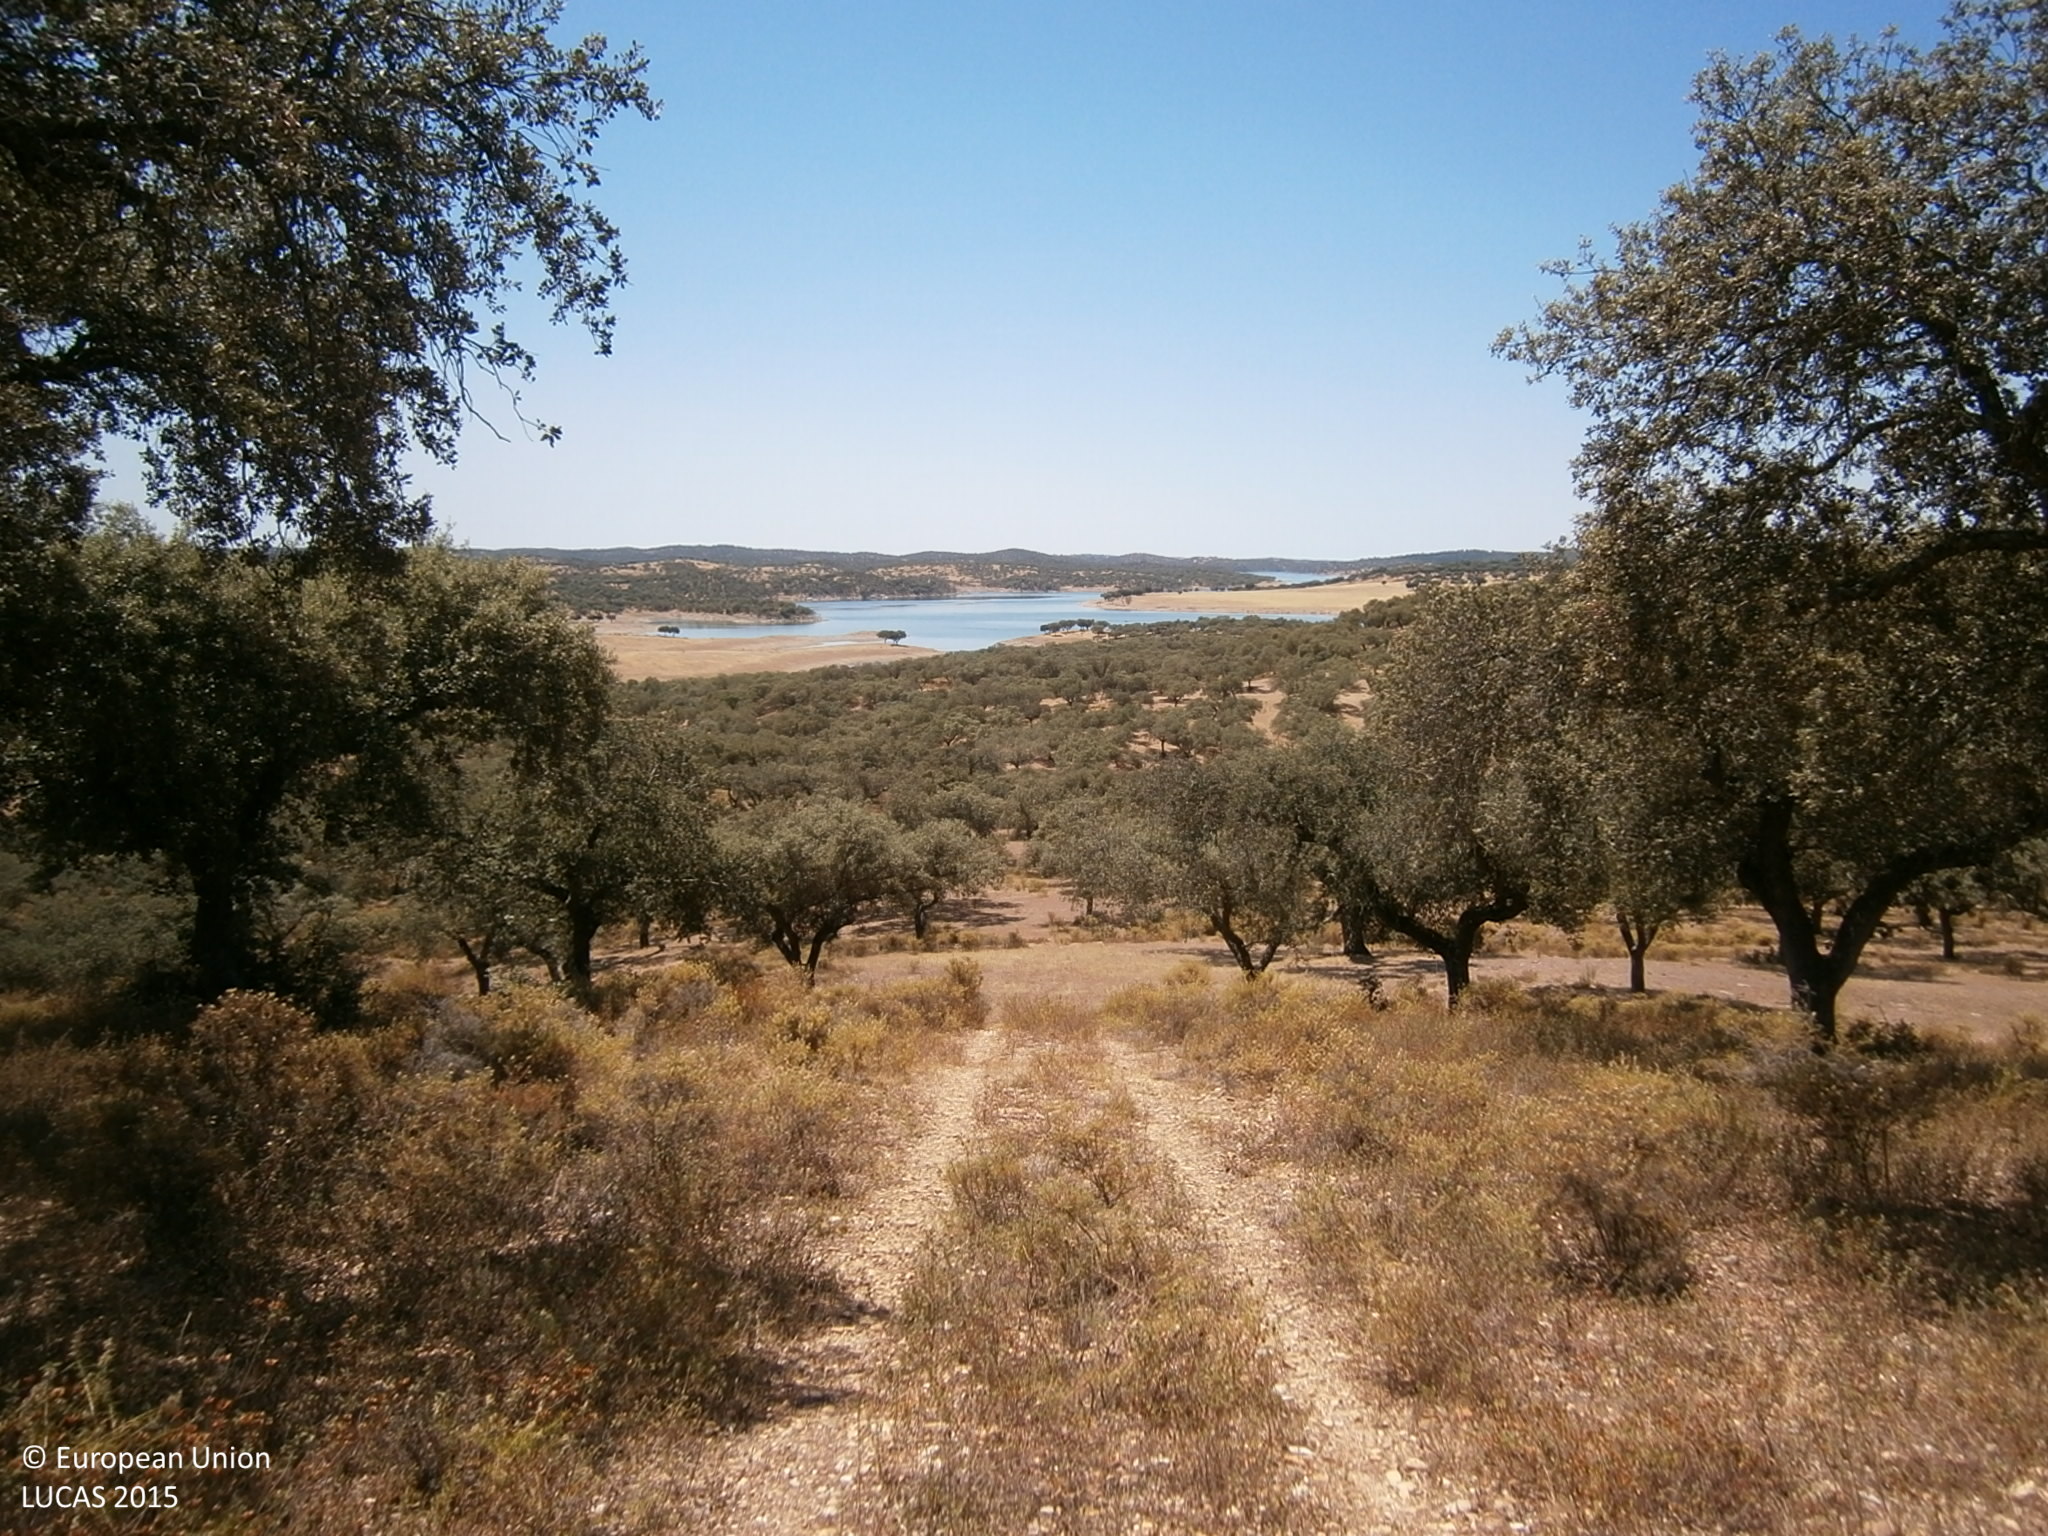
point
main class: Woodland
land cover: Broadleaved woodland
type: broadleaved evergreen forest
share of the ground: 25 - 50 %
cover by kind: shrubs 55 %, broadleaved forest trees 45 %
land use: Forestry
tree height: > 5 m
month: July
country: ES
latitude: 38.6348
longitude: -7.2456
